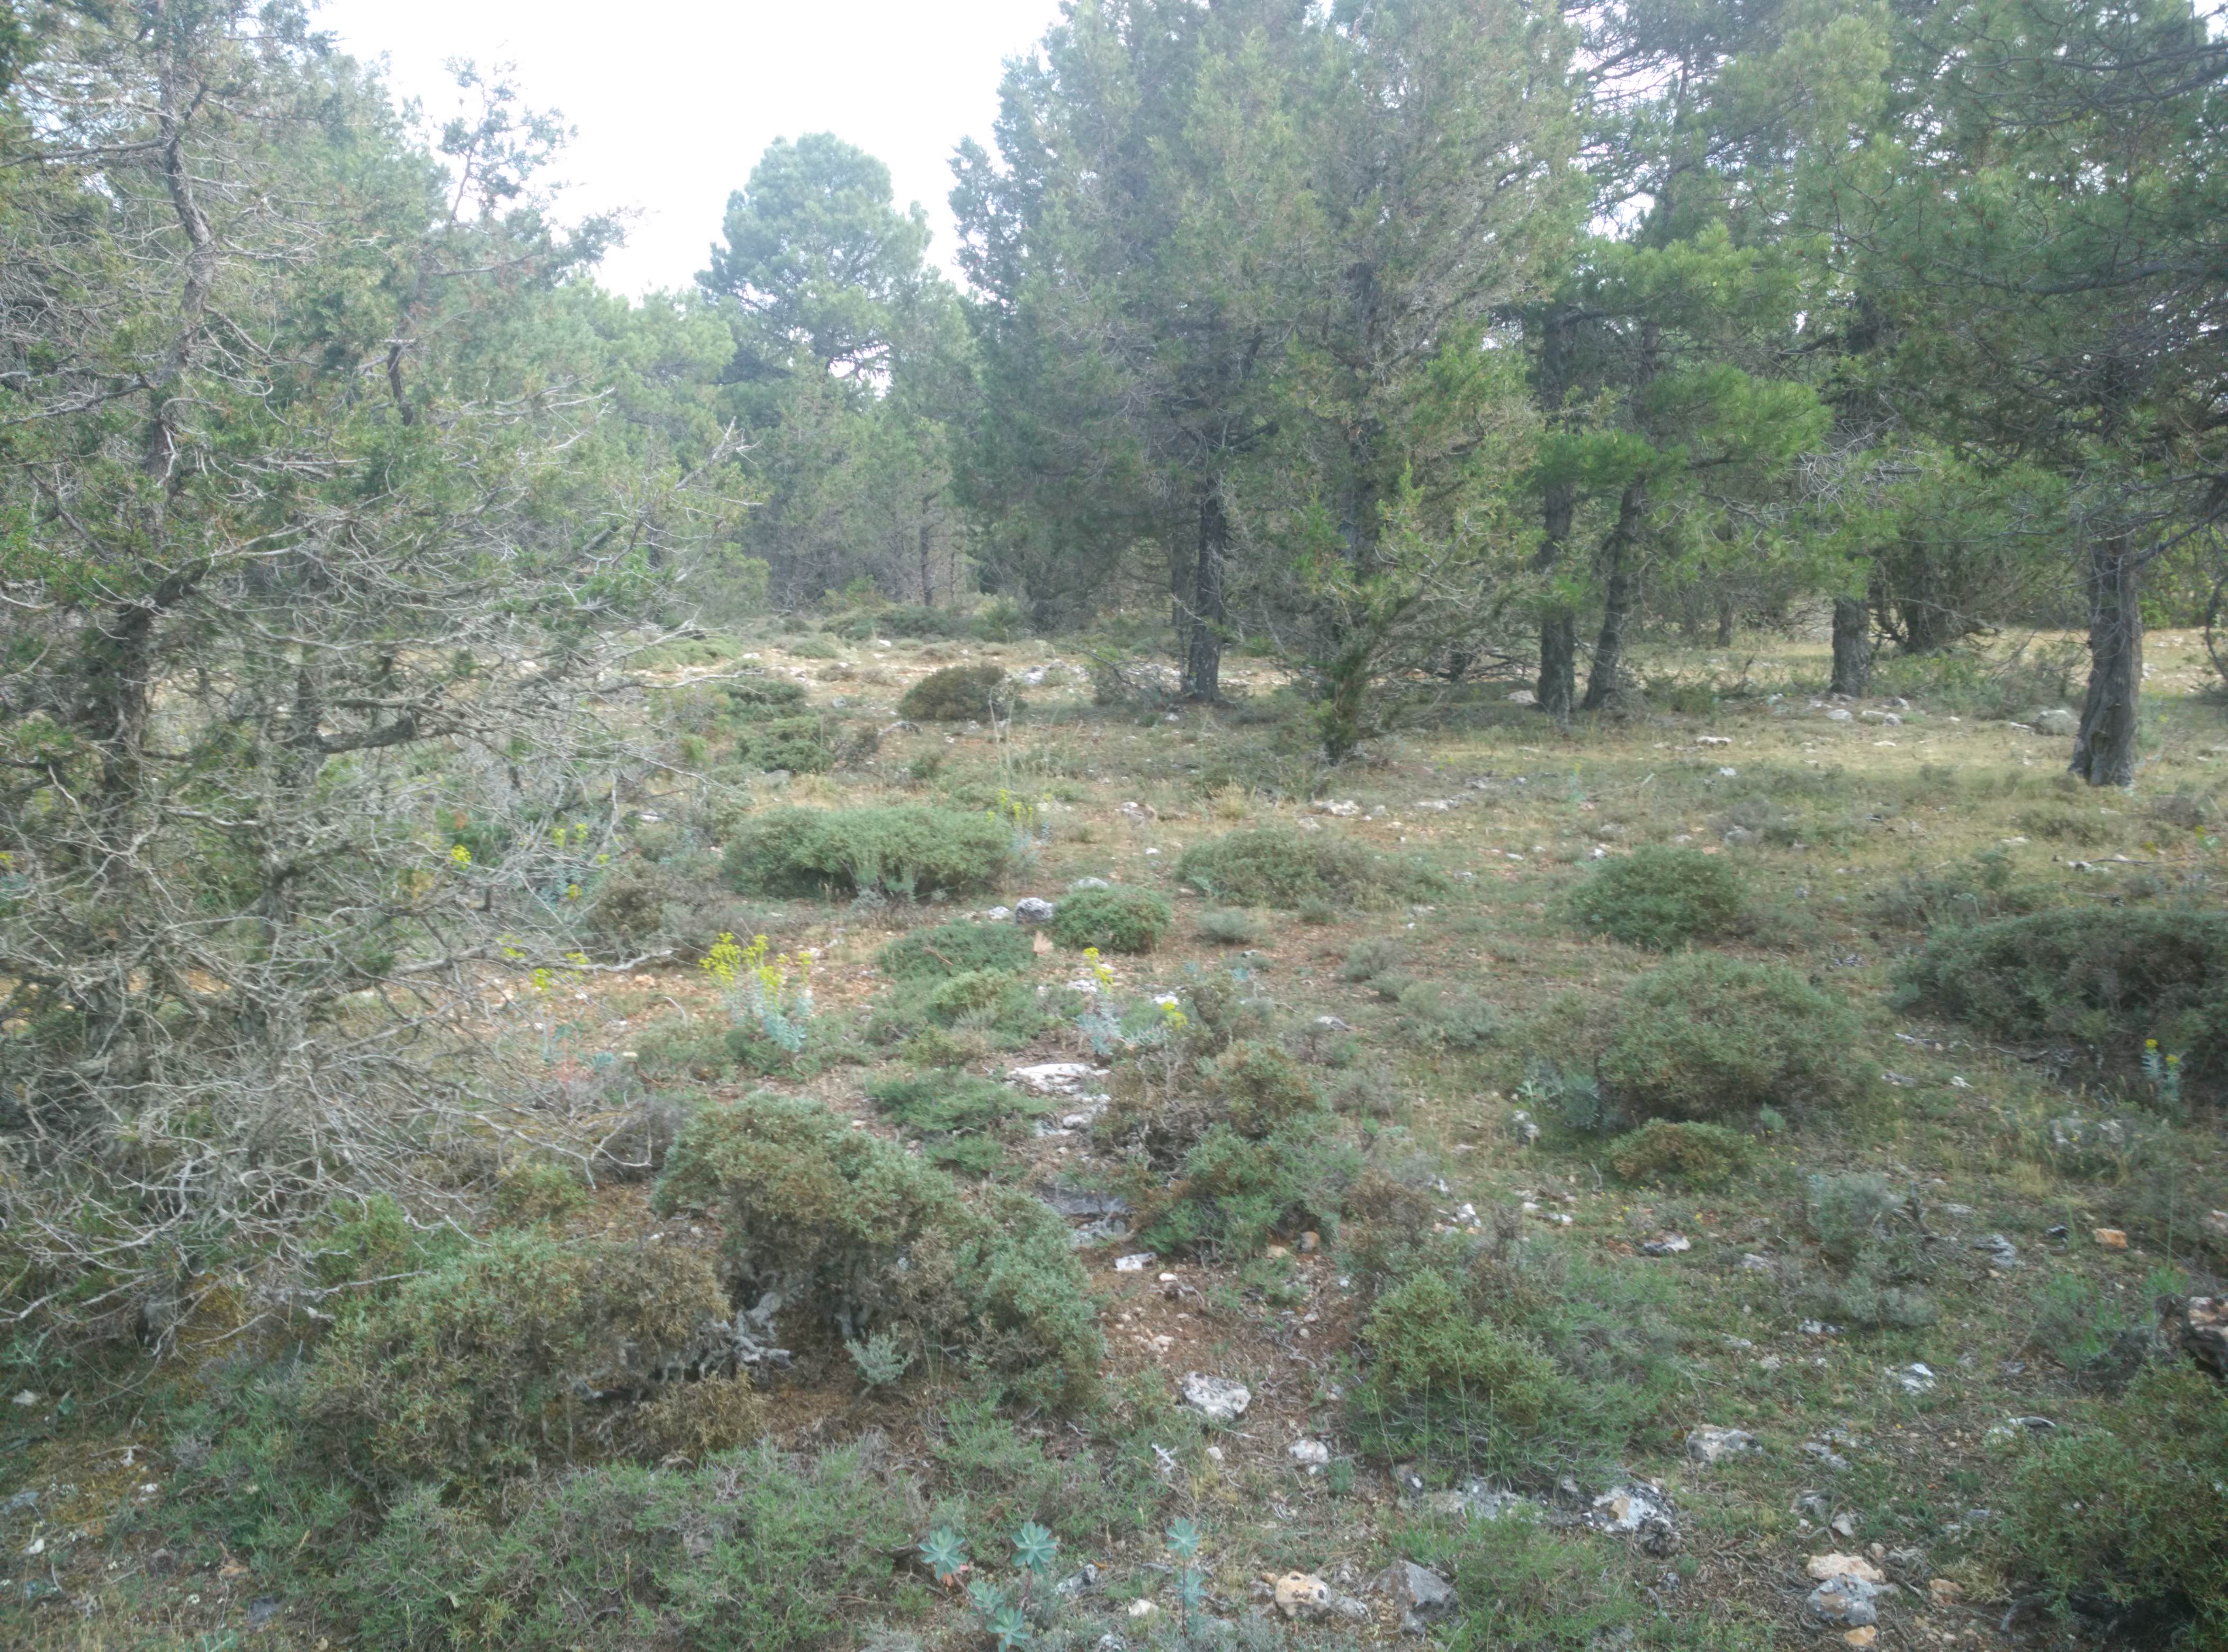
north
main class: Woodland
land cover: Other coniferous woodland
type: coniferous forest of the mediterranean region
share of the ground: 25 - 50 %
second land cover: Shrubland without tree cover
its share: 10 - 25 %
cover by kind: unconsolidated bare surface 60 %, coniferous forest trees 25 %, shrubs 10 %, herbaceous plants 5 %
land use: Forestry
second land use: Agriculture (excluding fallow land and kitchen gardens)
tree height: > 5 m
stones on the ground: > 50 %
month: June
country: ES
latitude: 40.7136
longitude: -2.0132
